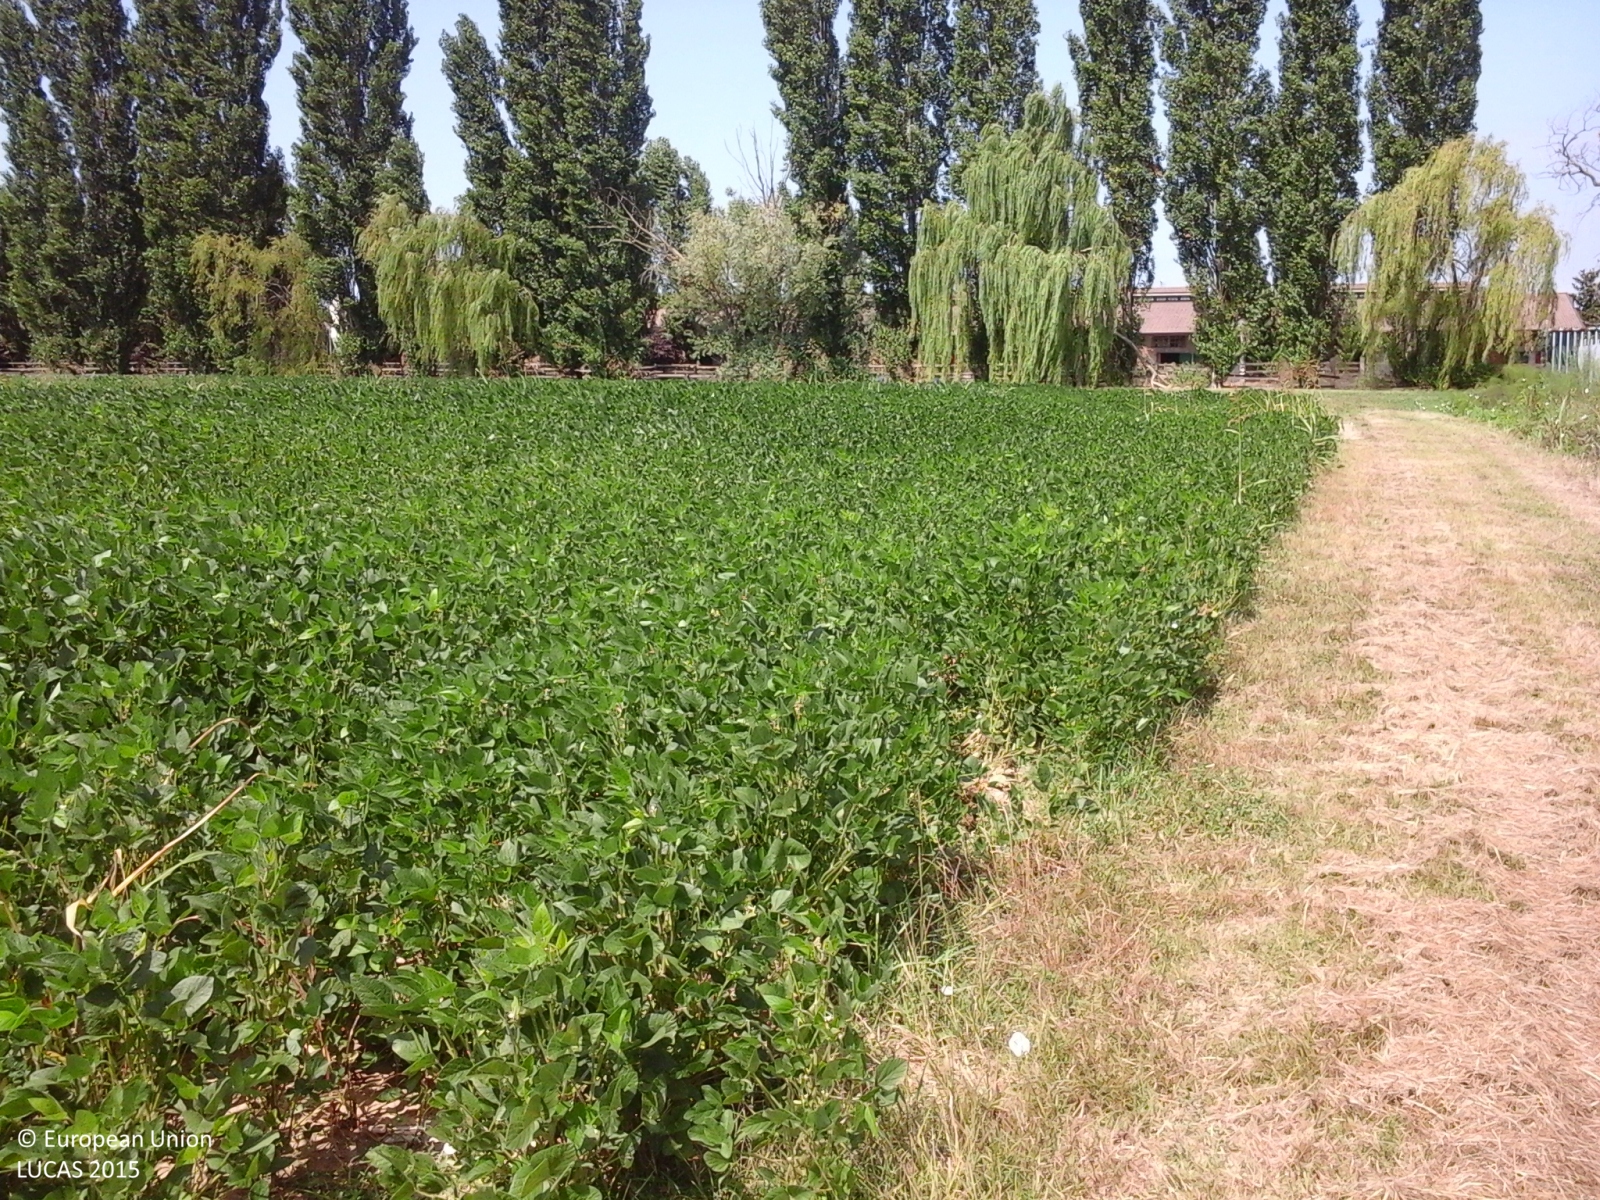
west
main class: Cropland
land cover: Soya
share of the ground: < 10 %
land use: Agriculture (excluding fallow land and kitchen gardens)
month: May
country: IT
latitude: 45.5686
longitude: 12.3413
